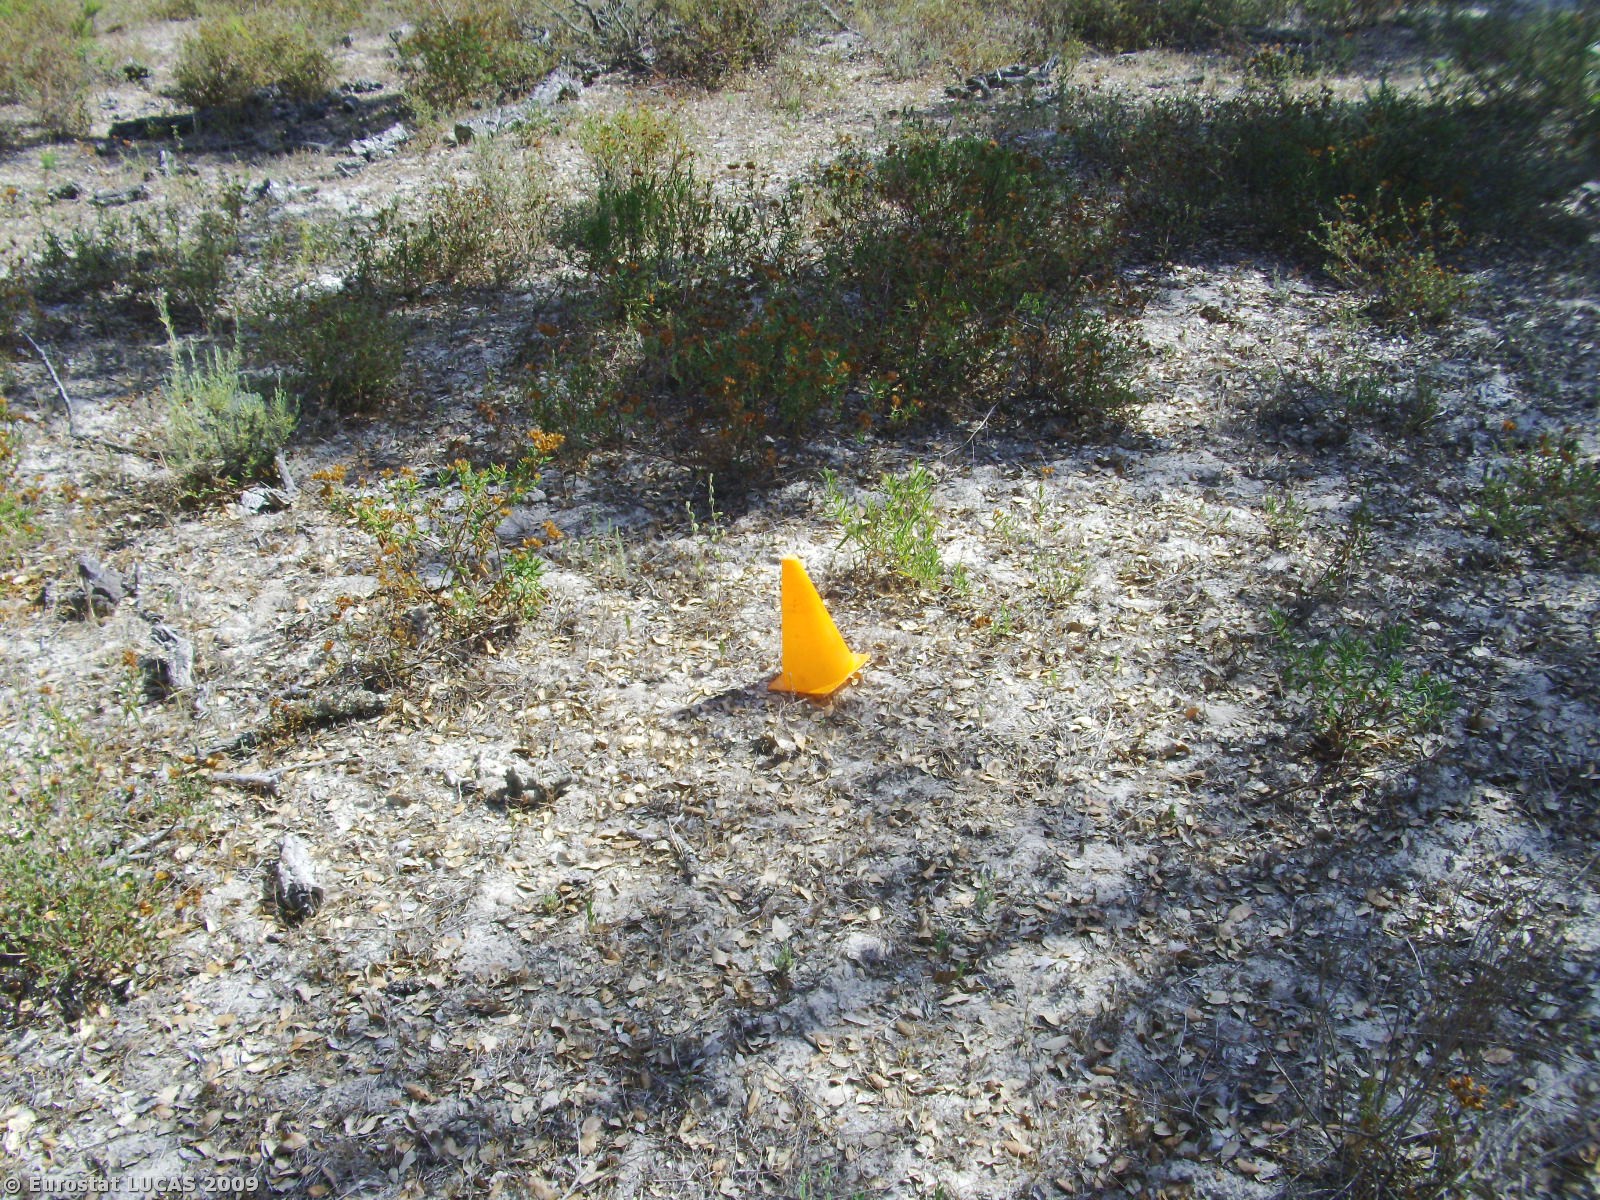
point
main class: Woodland
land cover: Broadleaved woodland
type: broadleaved evergreen forest
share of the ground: 25 - 50 %
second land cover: Spontaneously vegetated surfaces
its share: 50 - 75 %
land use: Forestry
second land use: Fallow land
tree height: > 5 m
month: August
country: PT
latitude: 38.5694
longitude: -8.6637
